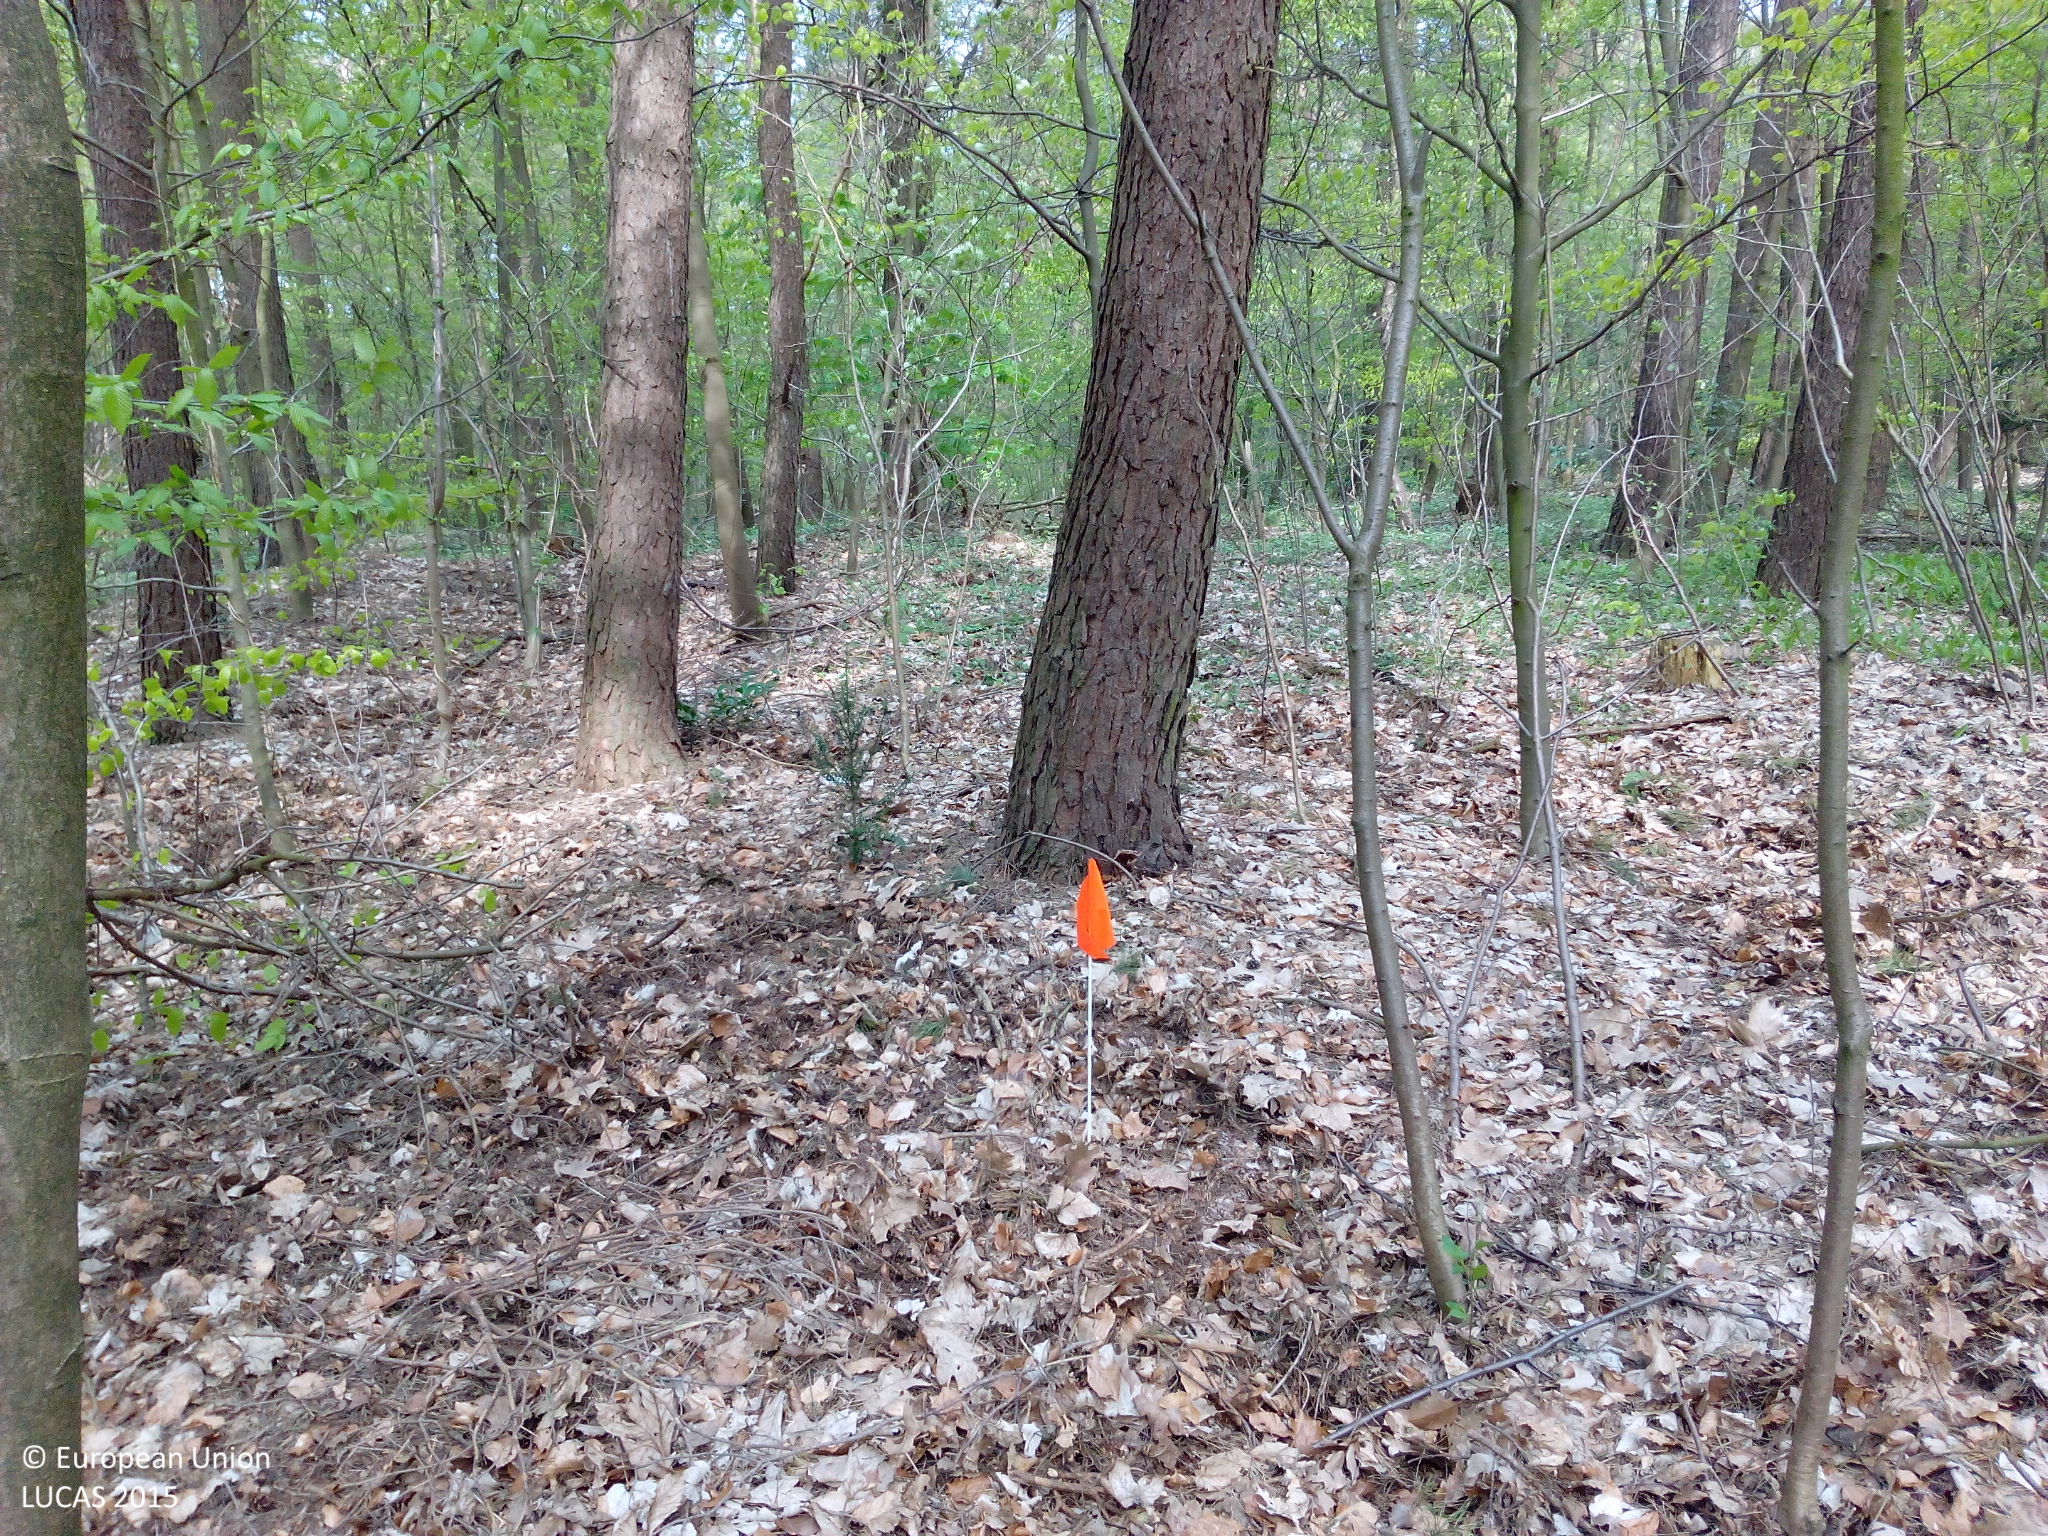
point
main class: Woodland
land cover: Pine dominated mixed woodland
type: hemiboreal forest and nemoral coniferous forest and mixed broadleaved-coniferous forest
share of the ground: > 75 %
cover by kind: coniferous forest trees 65 %, broadleaved forest trees 25 %, herbaceous plants 10 %
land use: Forestry
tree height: > 5 m
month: May
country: DE
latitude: 53.2138
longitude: 8.5780
